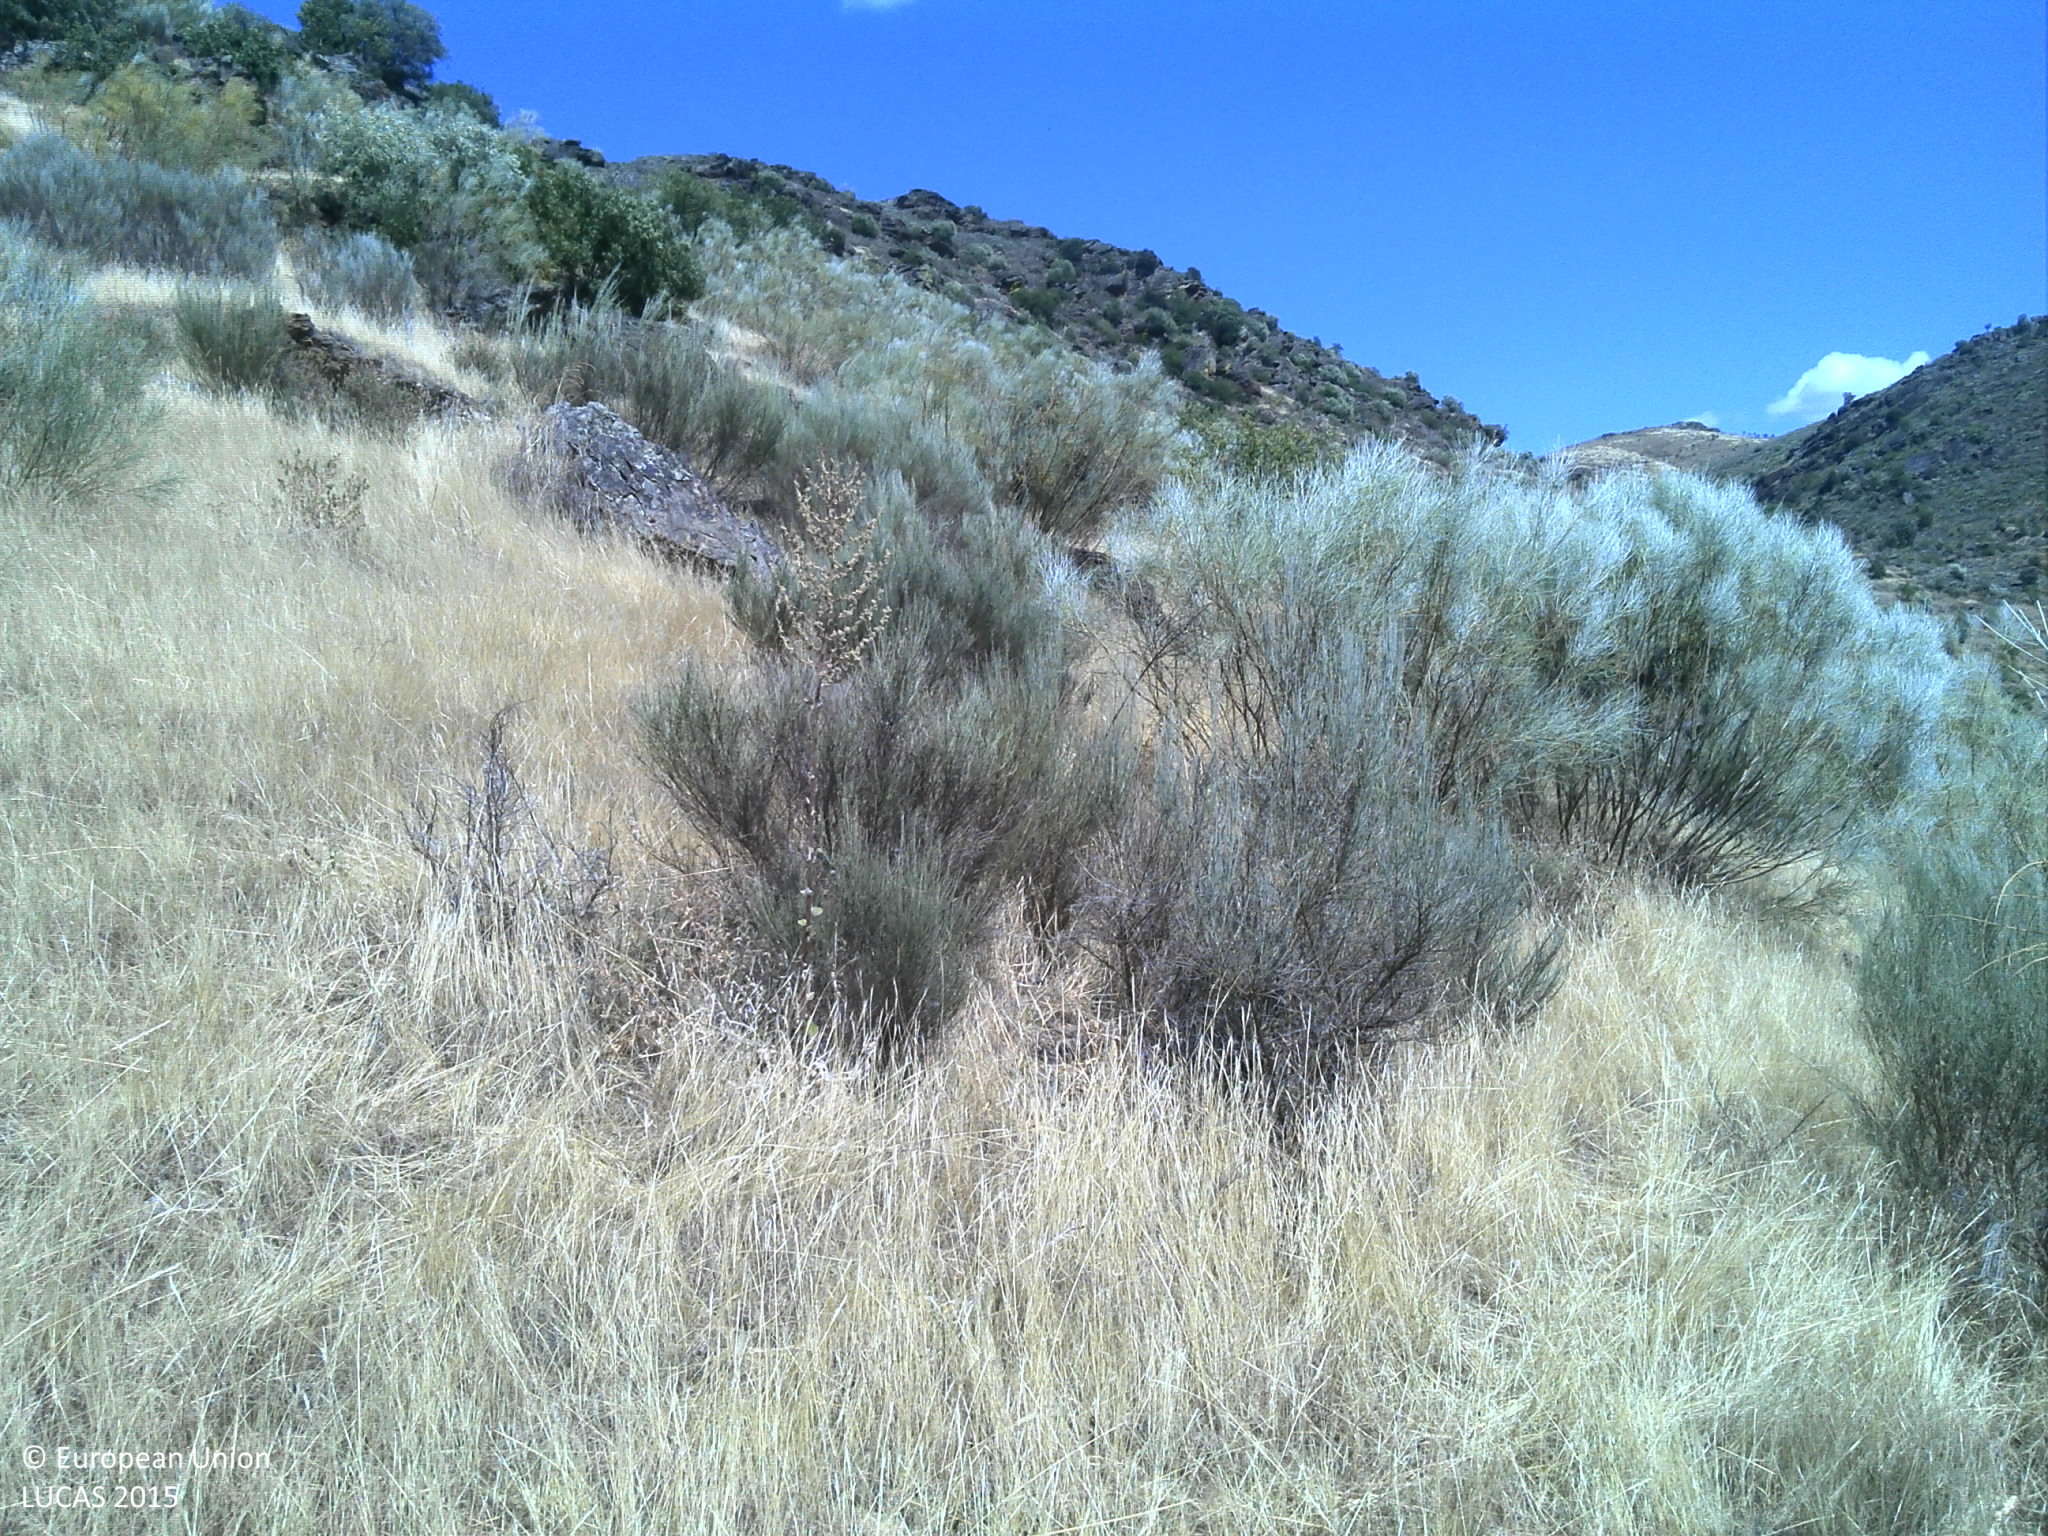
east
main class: Shrubland
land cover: Shrubland without tree cover
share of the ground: 25 - 50 %
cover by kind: herbaceous plants 55 %, shrubs 30 %, unconsolidated bare surface 10 %, consolidated bare surface 5 %
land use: Abandoned areas
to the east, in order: Shrubland without tree cover; Nuts trees; Rocks and stones; Nuts trees; Shrubland with sparse tree cover; Shrubland without tree cover
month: July
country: PT
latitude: 41.3301
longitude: -7.0193
